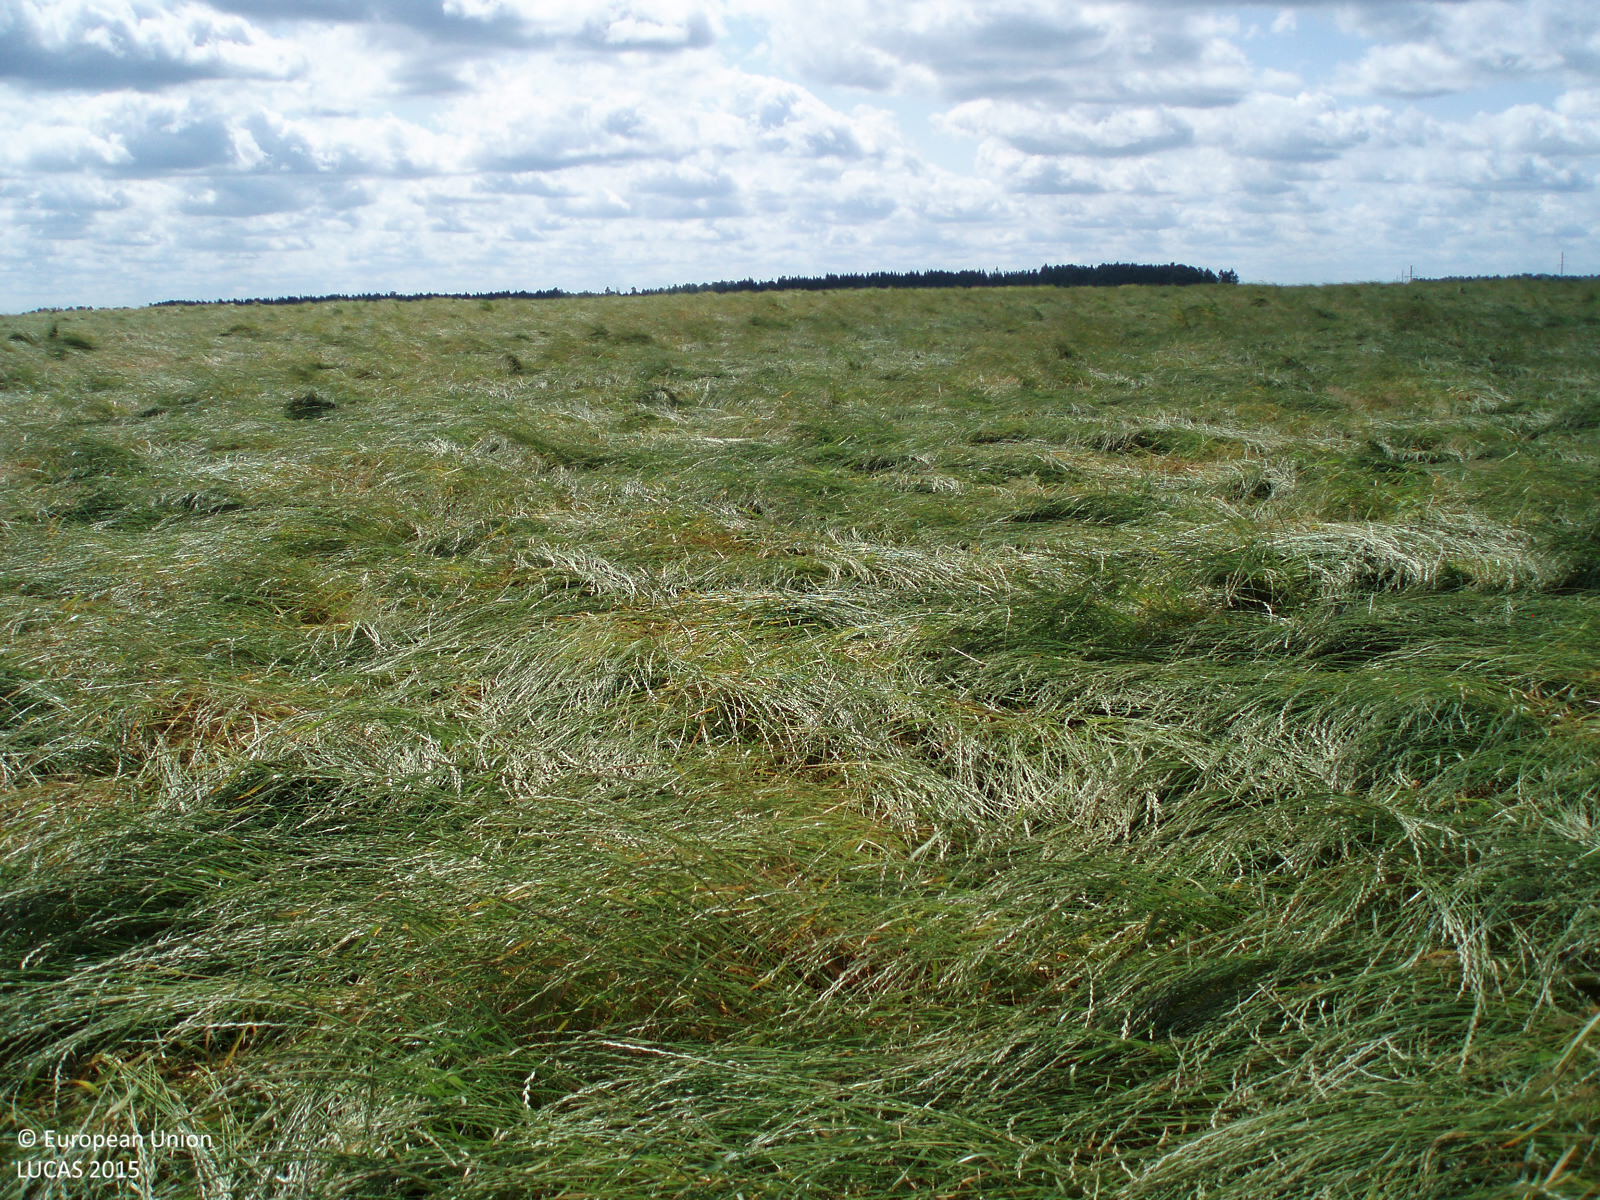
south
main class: Cropland
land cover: Temporary grasslands
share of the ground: > 75 %
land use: Agriculture (excluding fallow land and kitchen gardens)
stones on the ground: < 10 %
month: July
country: LT
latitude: 56.0942
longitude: 22.9416
